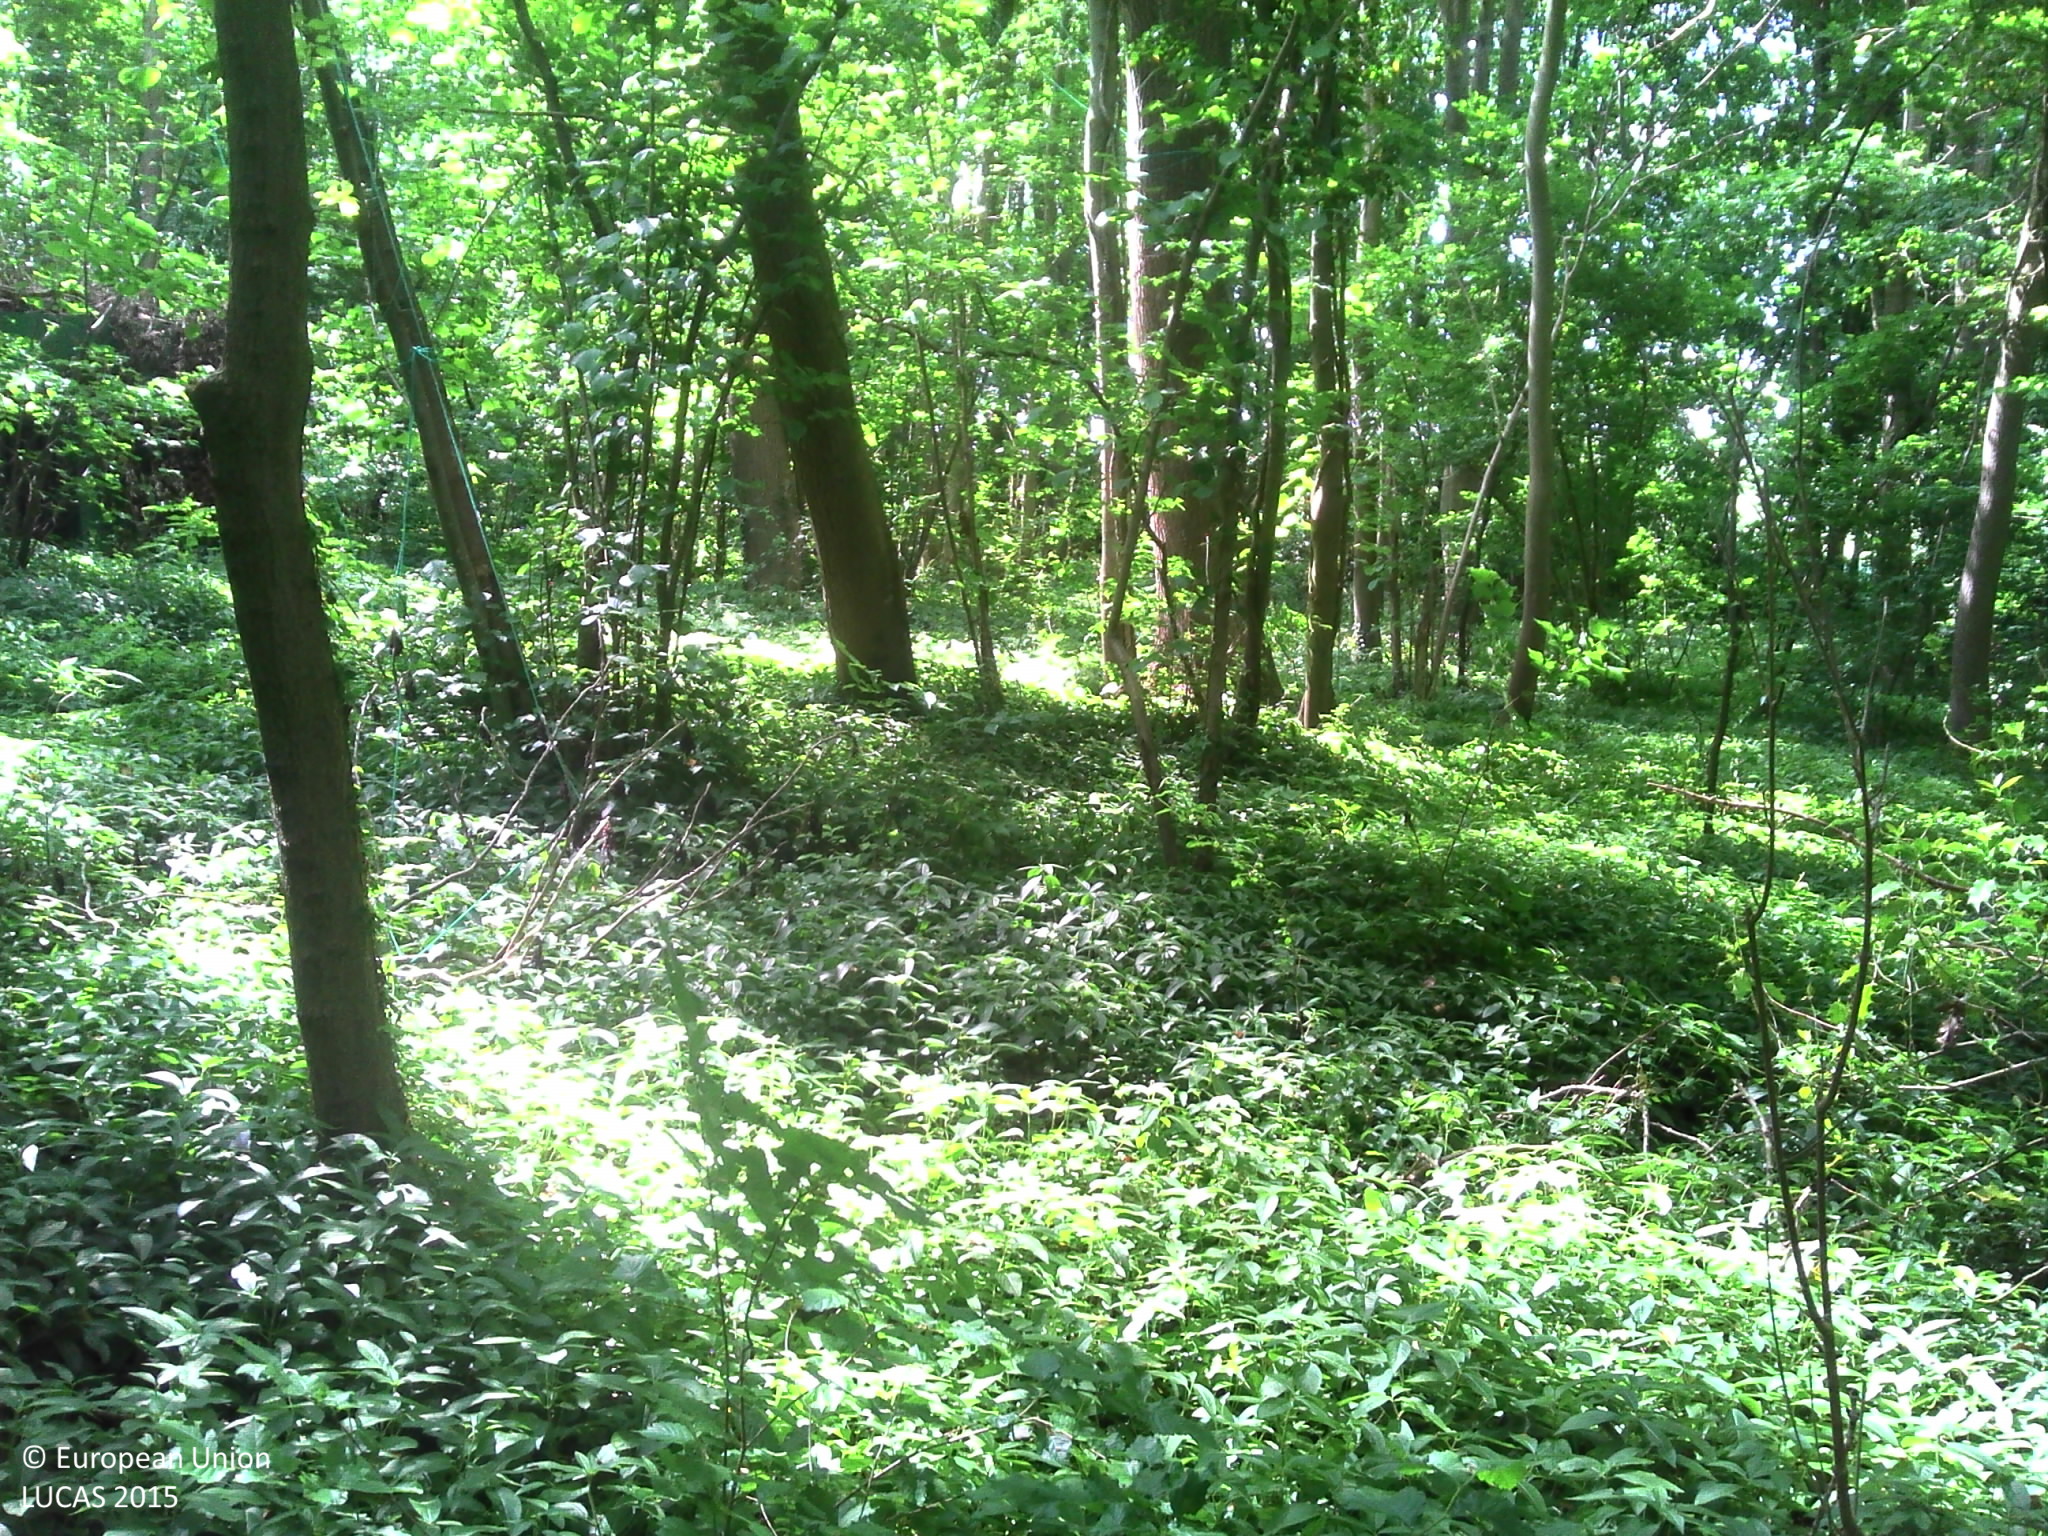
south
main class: Woodland
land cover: Broadleaved woodland
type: exotic forest
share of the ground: > 75 %
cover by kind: broadleaved forest trees 85 %, herbaceous plants 10 %, lichens and mosses 5 %
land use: Forestry
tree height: > 5 m
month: June
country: FR
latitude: 50.0977
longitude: 1.6925
